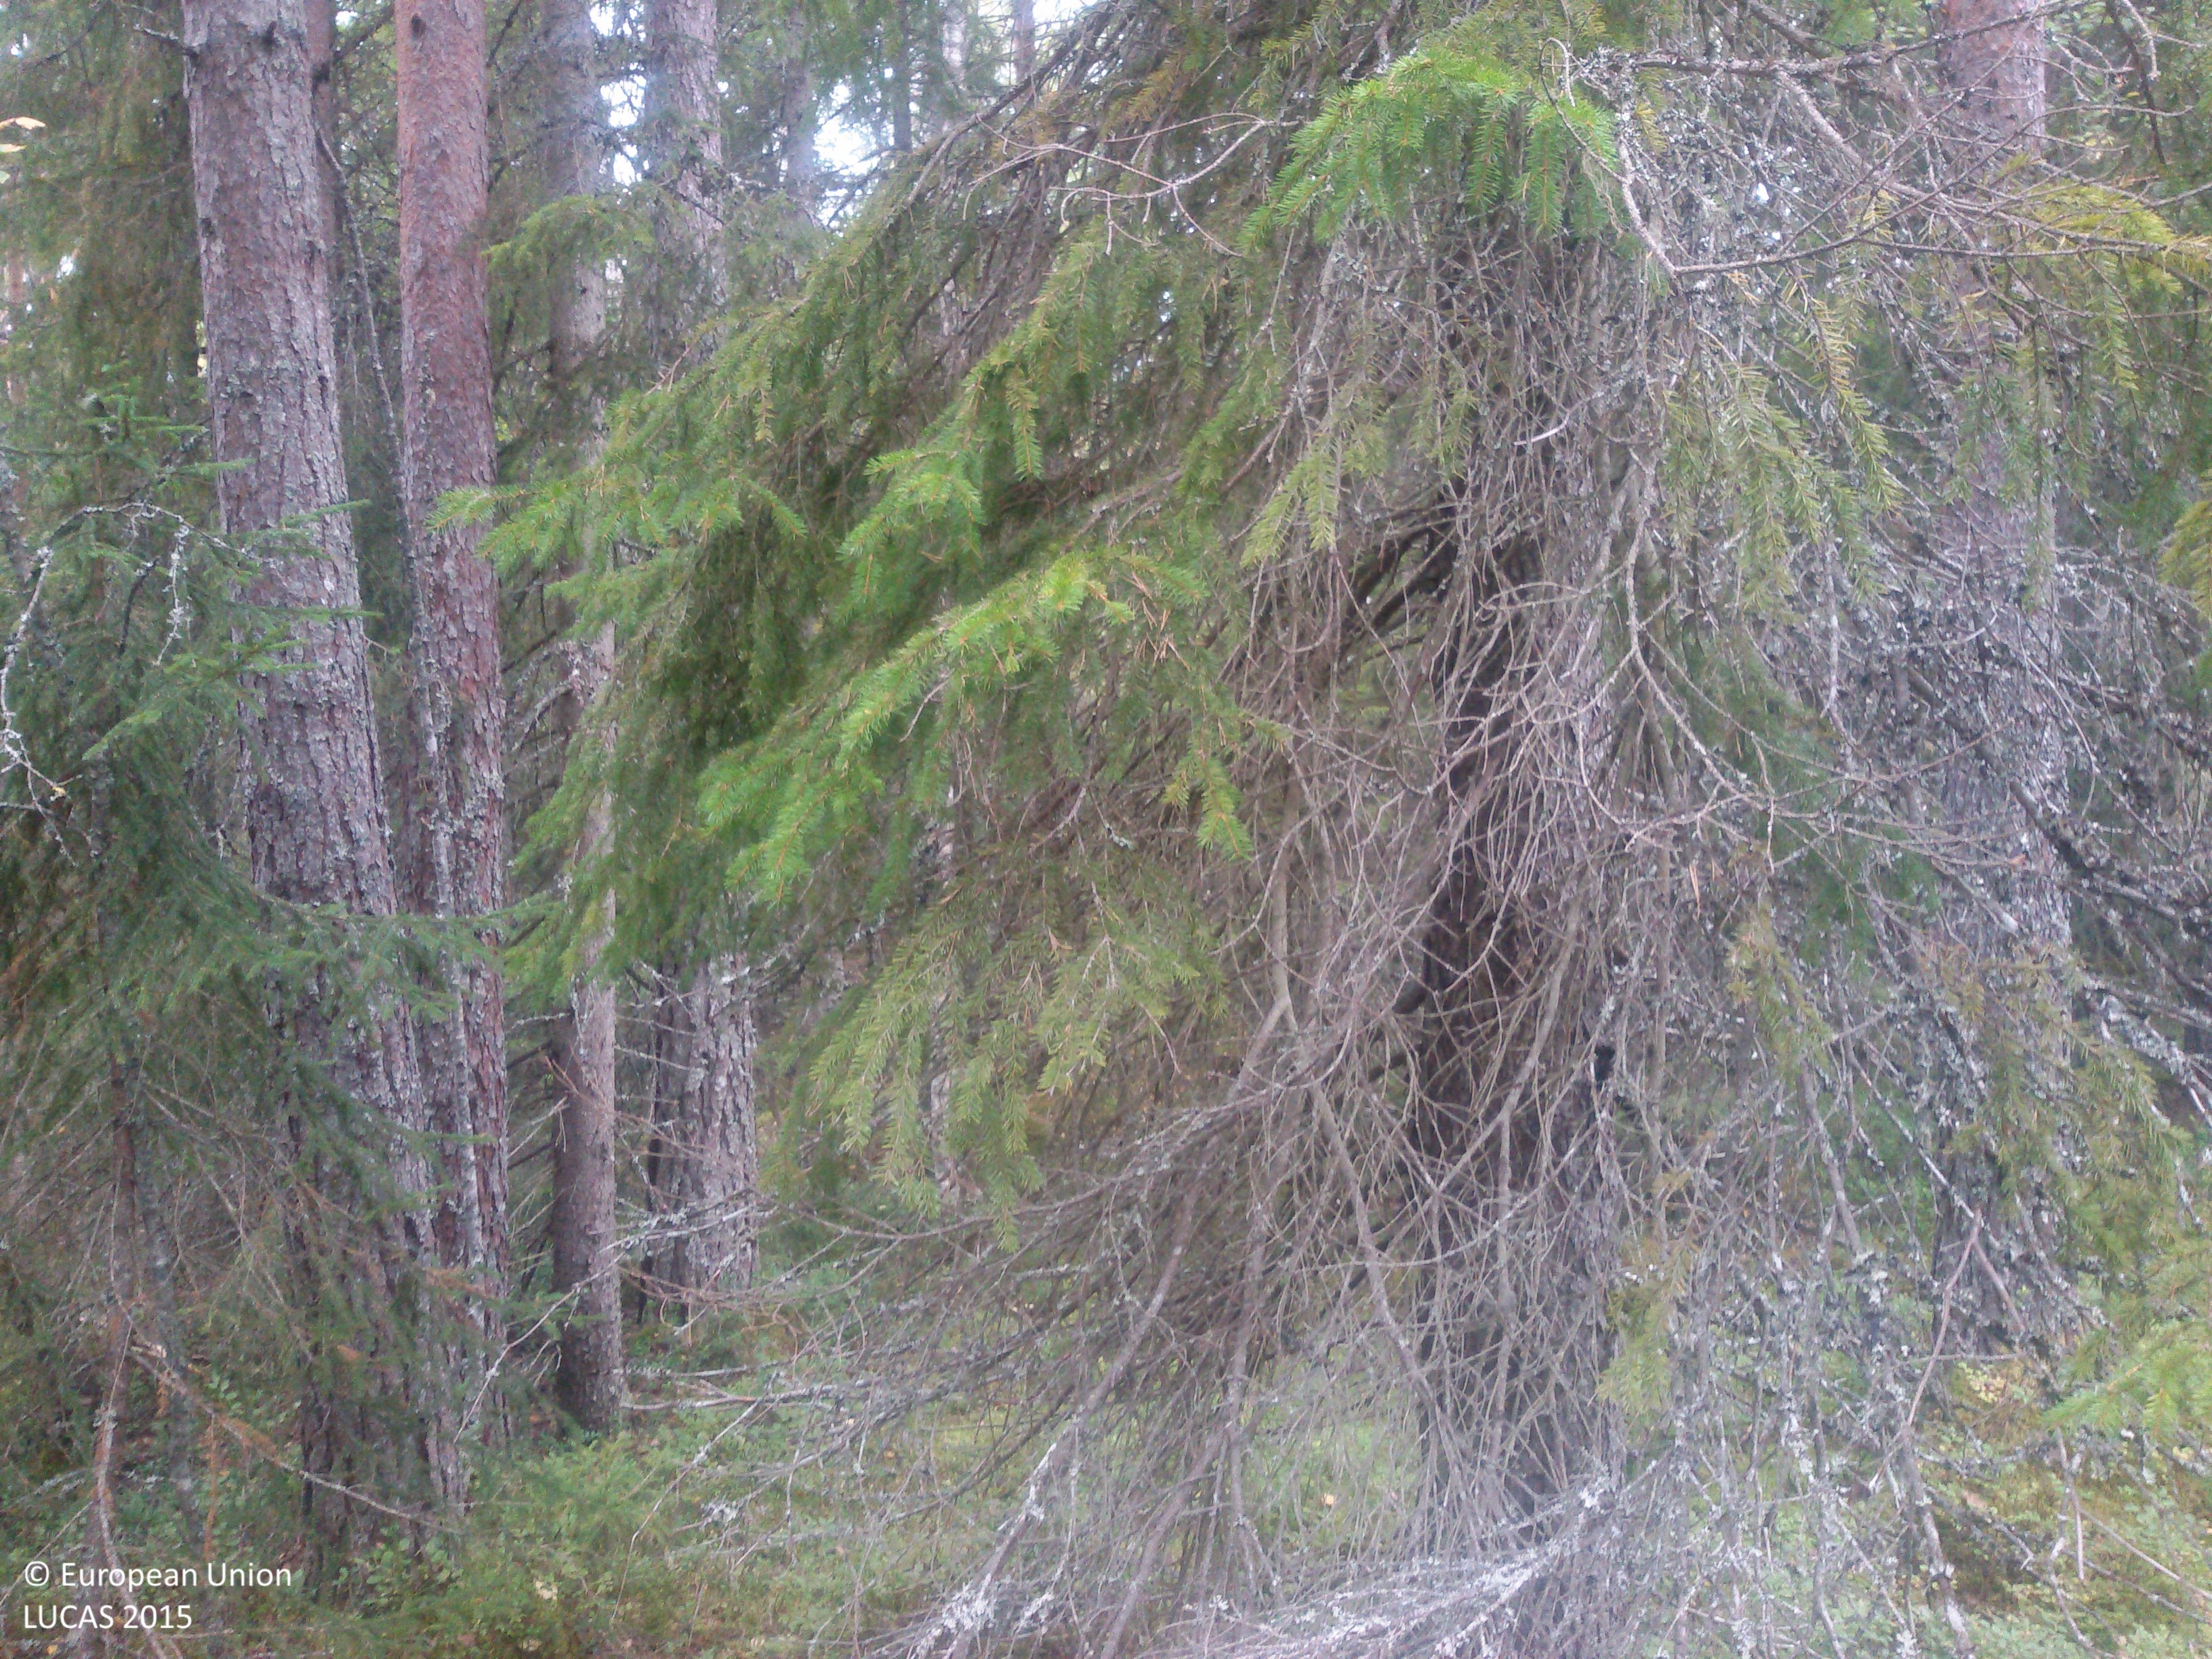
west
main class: Woodland
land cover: Pine dominated coniferous woodland
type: boreal forest
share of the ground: 50 - 75 %
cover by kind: coniferous forest trees 70 %, herbaceous plants 15 %, lichens and mosses 15 %
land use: Forestry
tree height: > 5 m
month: September
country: SE
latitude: 61.0496
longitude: 14.9678
